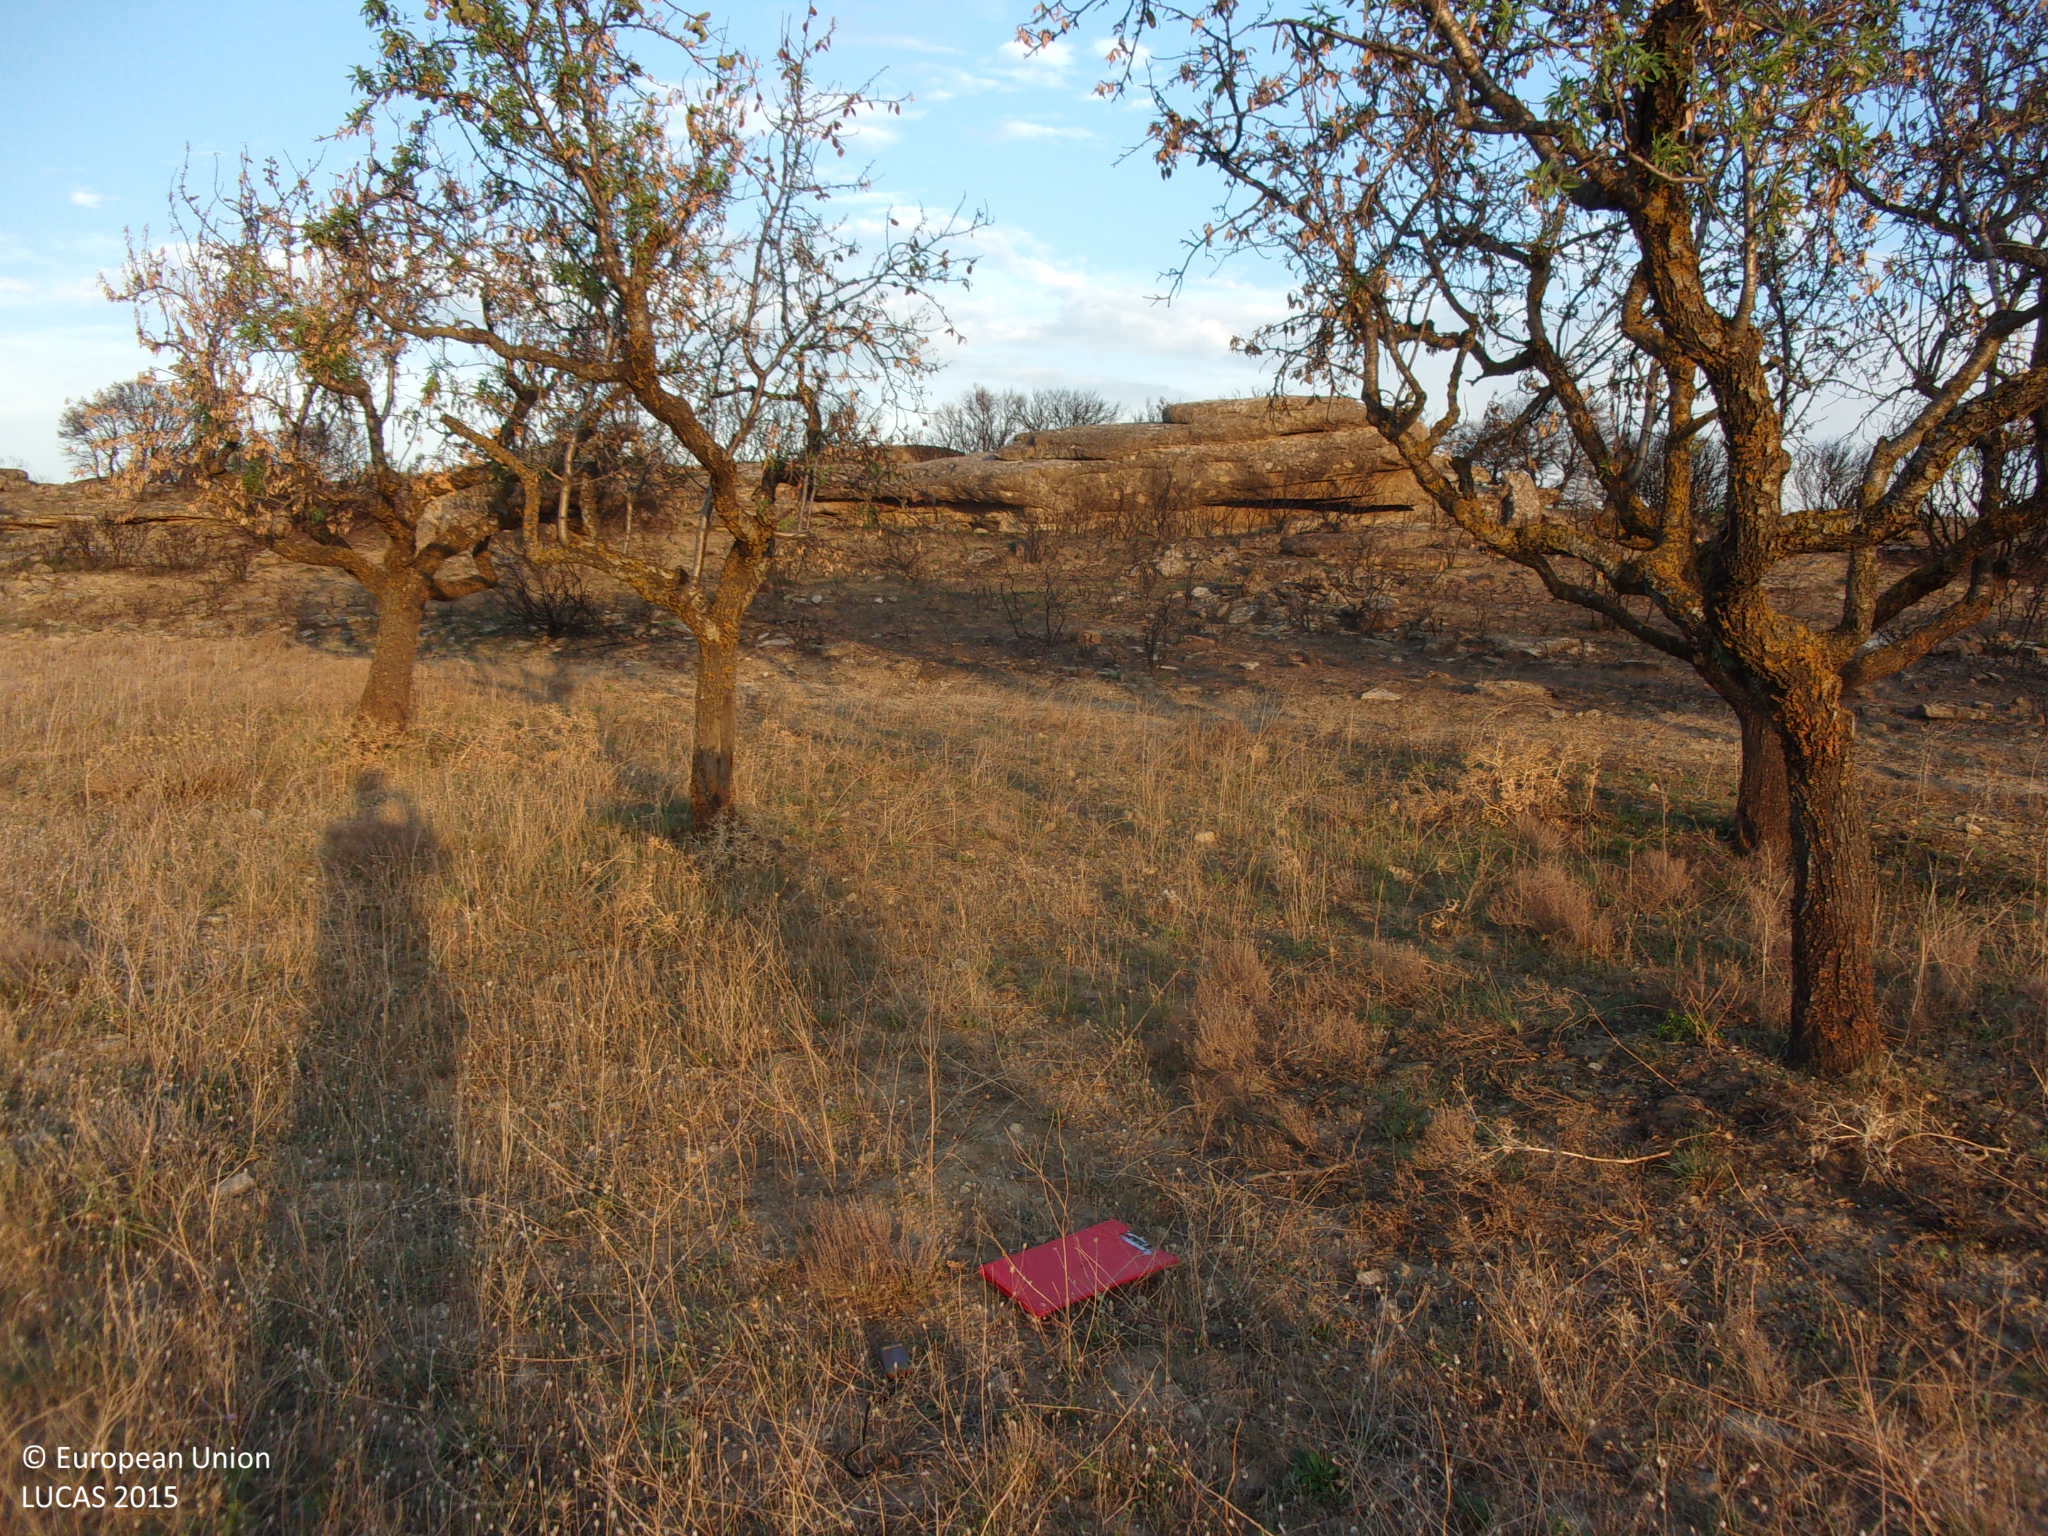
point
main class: Cropland
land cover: Nuts trees
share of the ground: 10 - 25 %
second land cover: Spontaneously vegetated surfaces
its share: > 75 %
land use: Agriculture (excluding fallow land and kitchen gardens)
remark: Burnt area
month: August
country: ES
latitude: 42.2529
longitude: -1.1687
